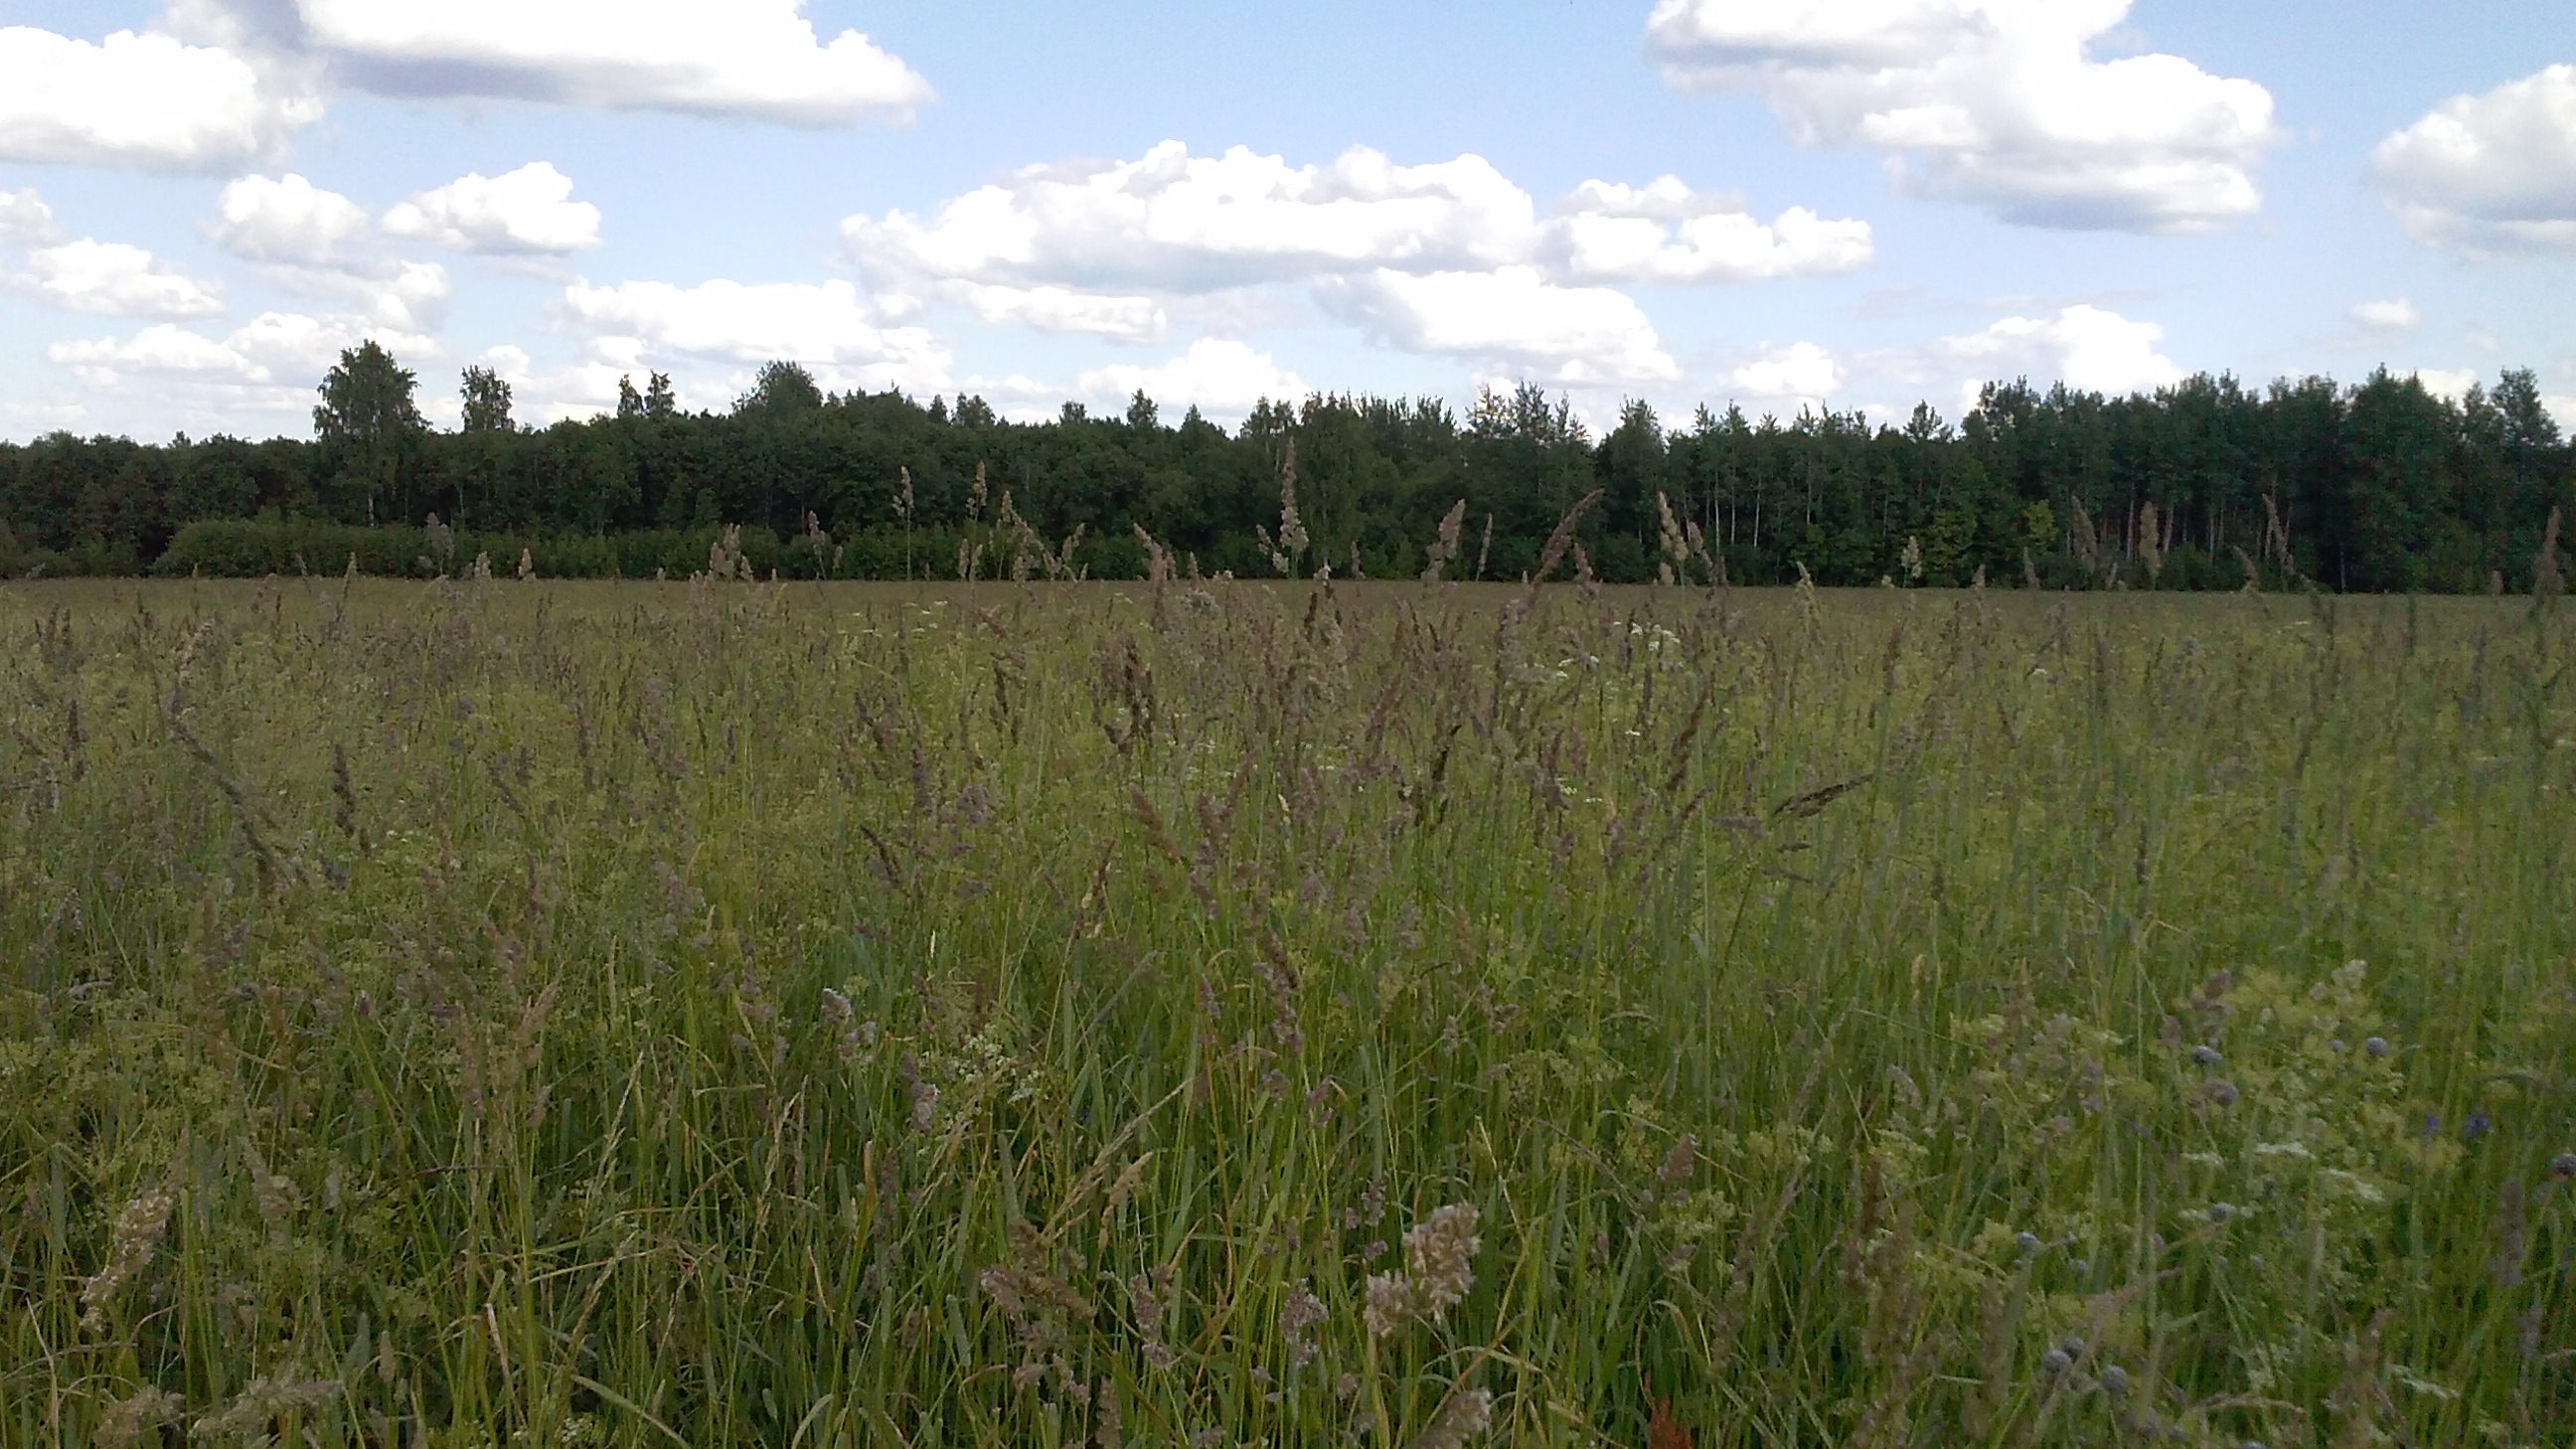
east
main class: Grassland
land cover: Grassland without tree/shrub cover
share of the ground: > 75 %
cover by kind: herbaceous plants 100 %
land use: Agriculture (excluding fallow land and kitchen gardens)
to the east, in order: Grassland without tree/shrub cover; Broadleaved woodland
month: June
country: LV
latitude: 56.5389
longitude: 27.9022
